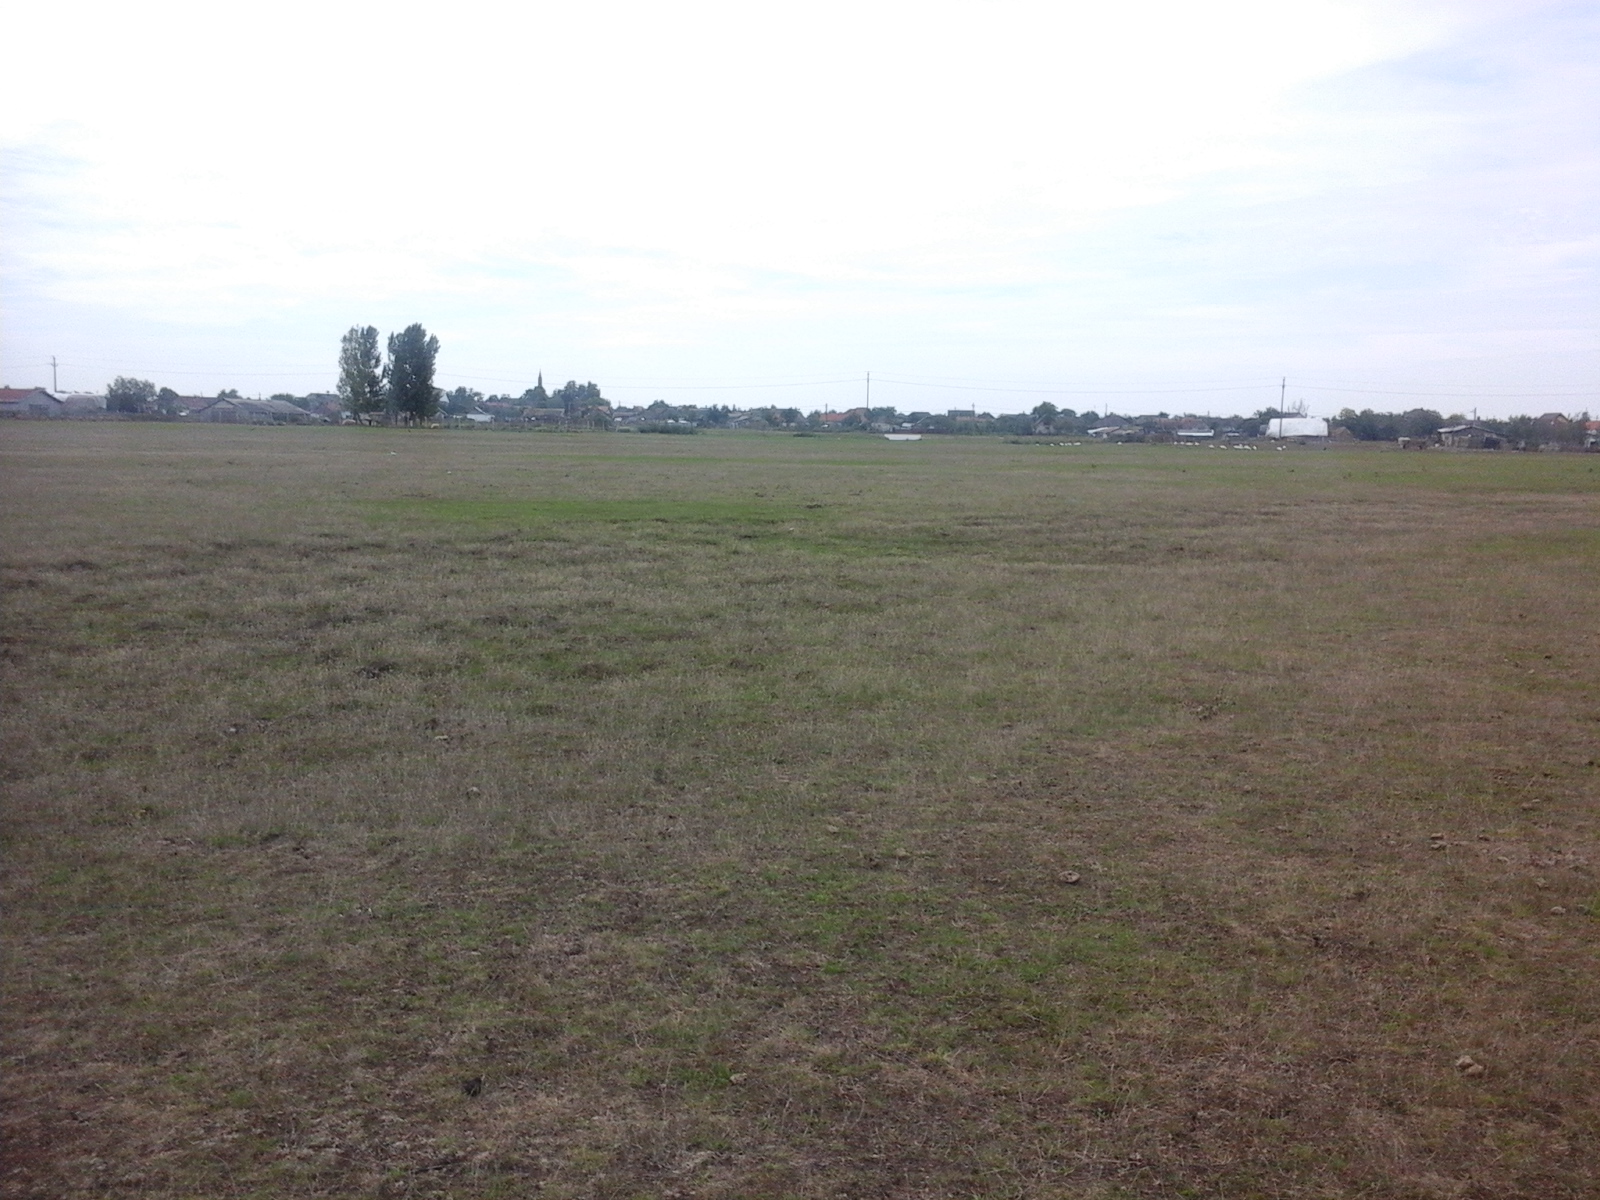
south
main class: Grassland
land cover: Grassland without tree/shrub cover
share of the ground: > 75 %
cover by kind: herbaceous plants 100 %
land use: Agriculture (excluding fallow land and kitchen gardens)
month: August
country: RO
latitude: 46.5168
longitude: 21.4422
